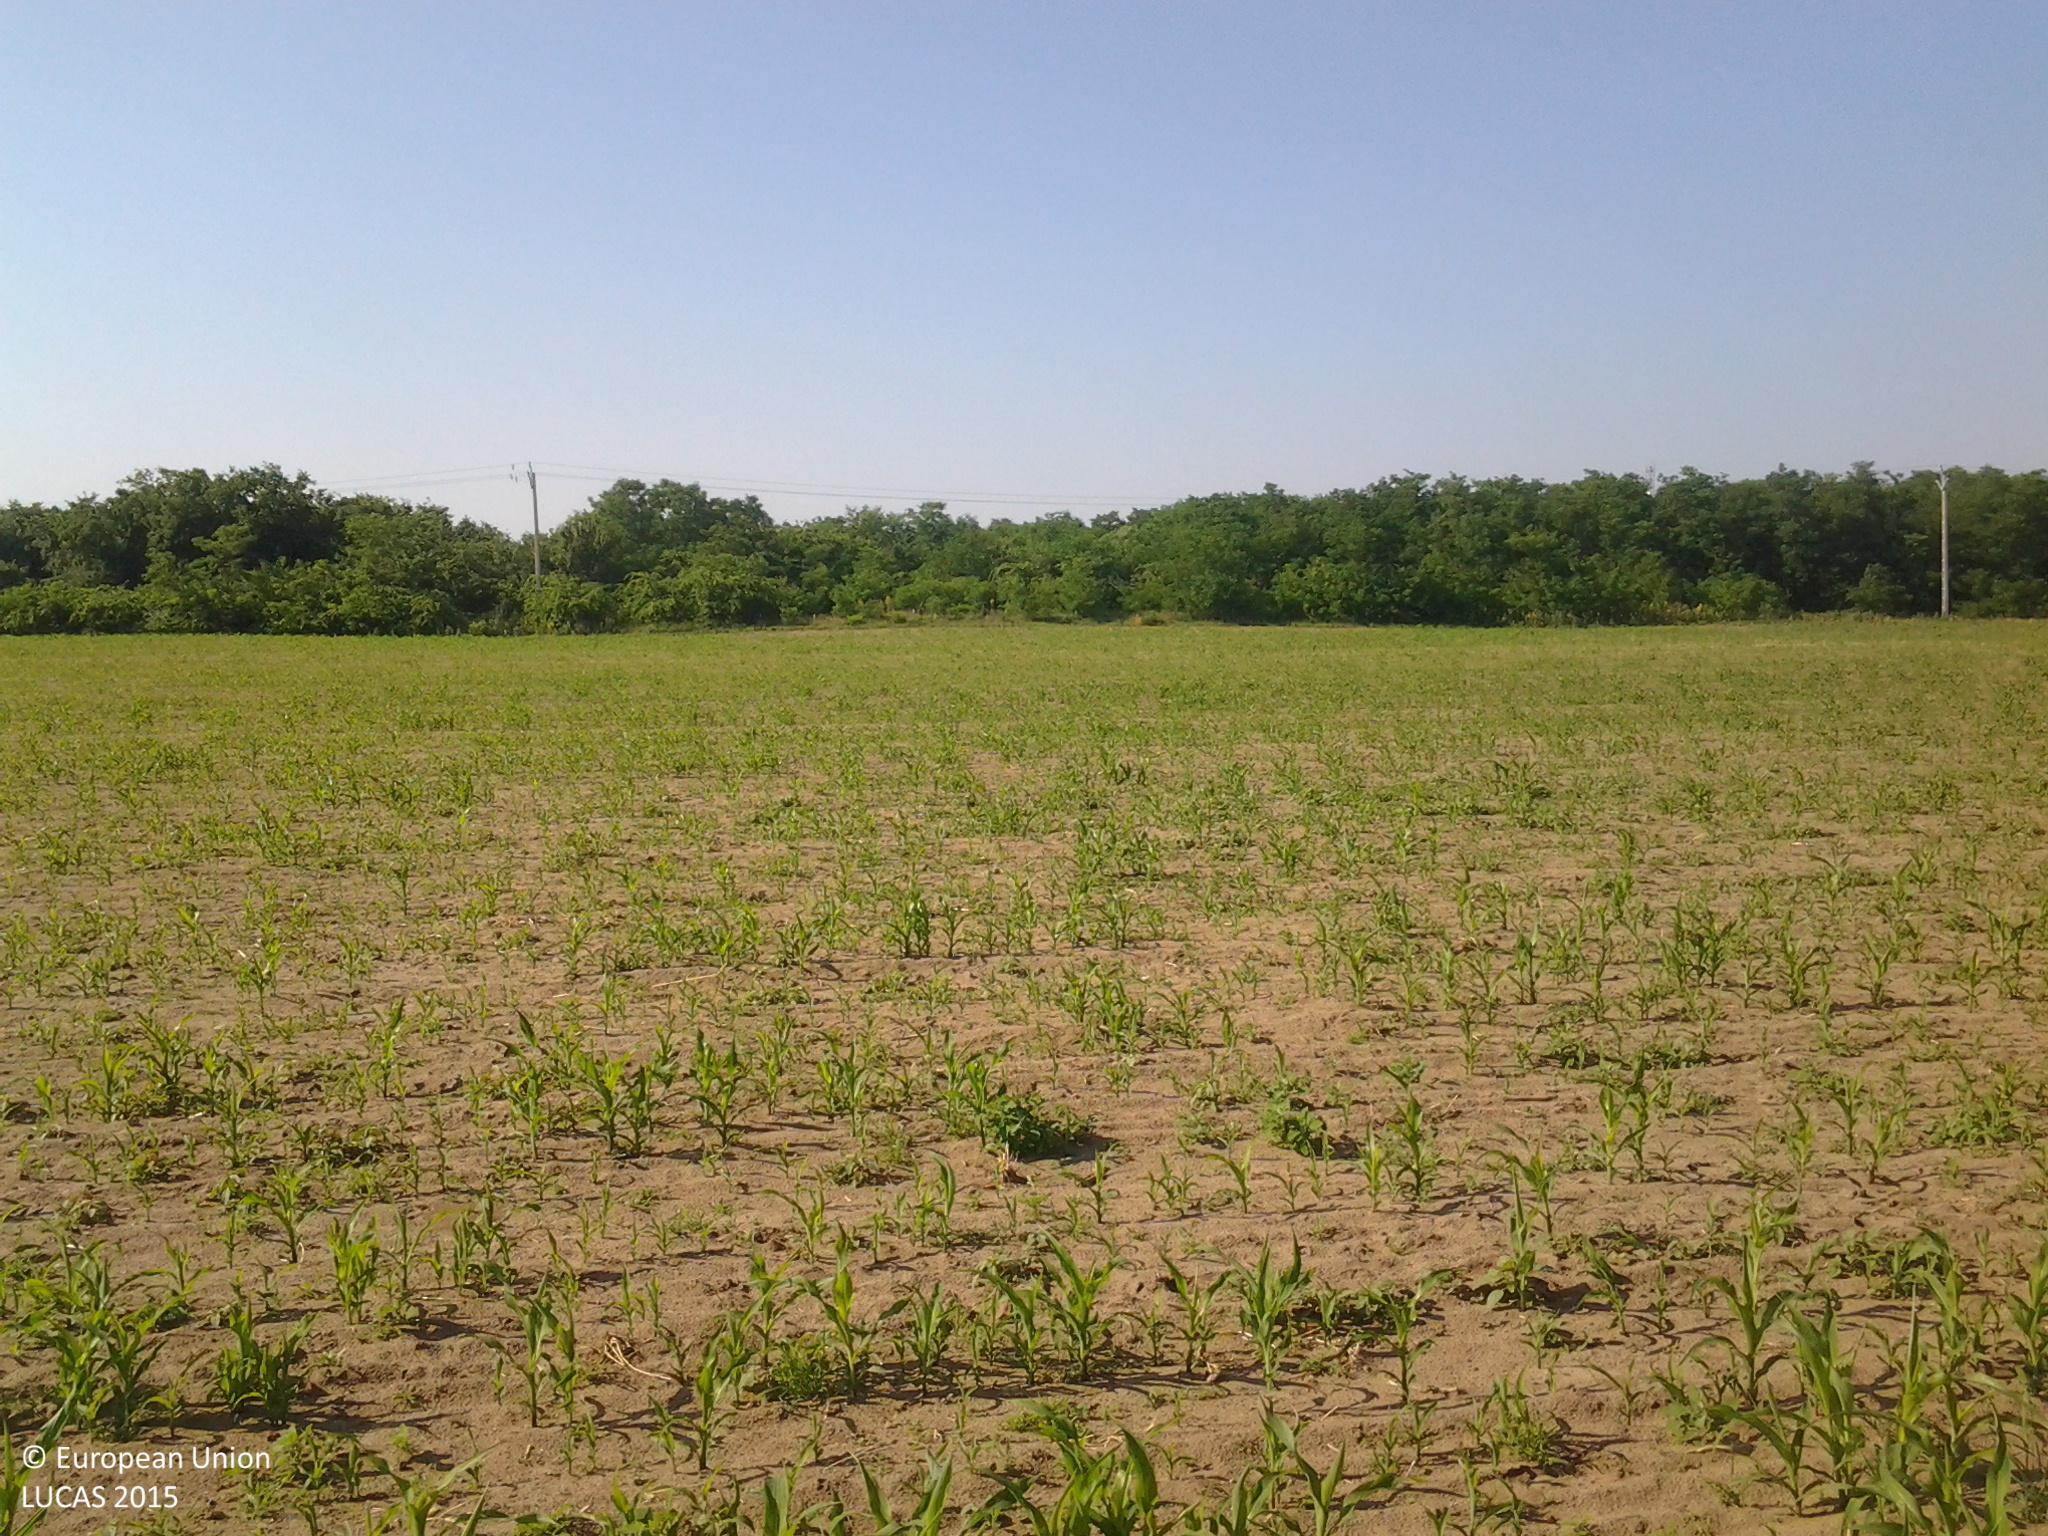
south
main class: Cropland
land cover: Maize
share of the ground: 50 - 75 %
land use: Agriculture (excluding fallow land and kitchen gardens)
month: July
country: HU
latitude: 46.6310
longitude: 19.5402
